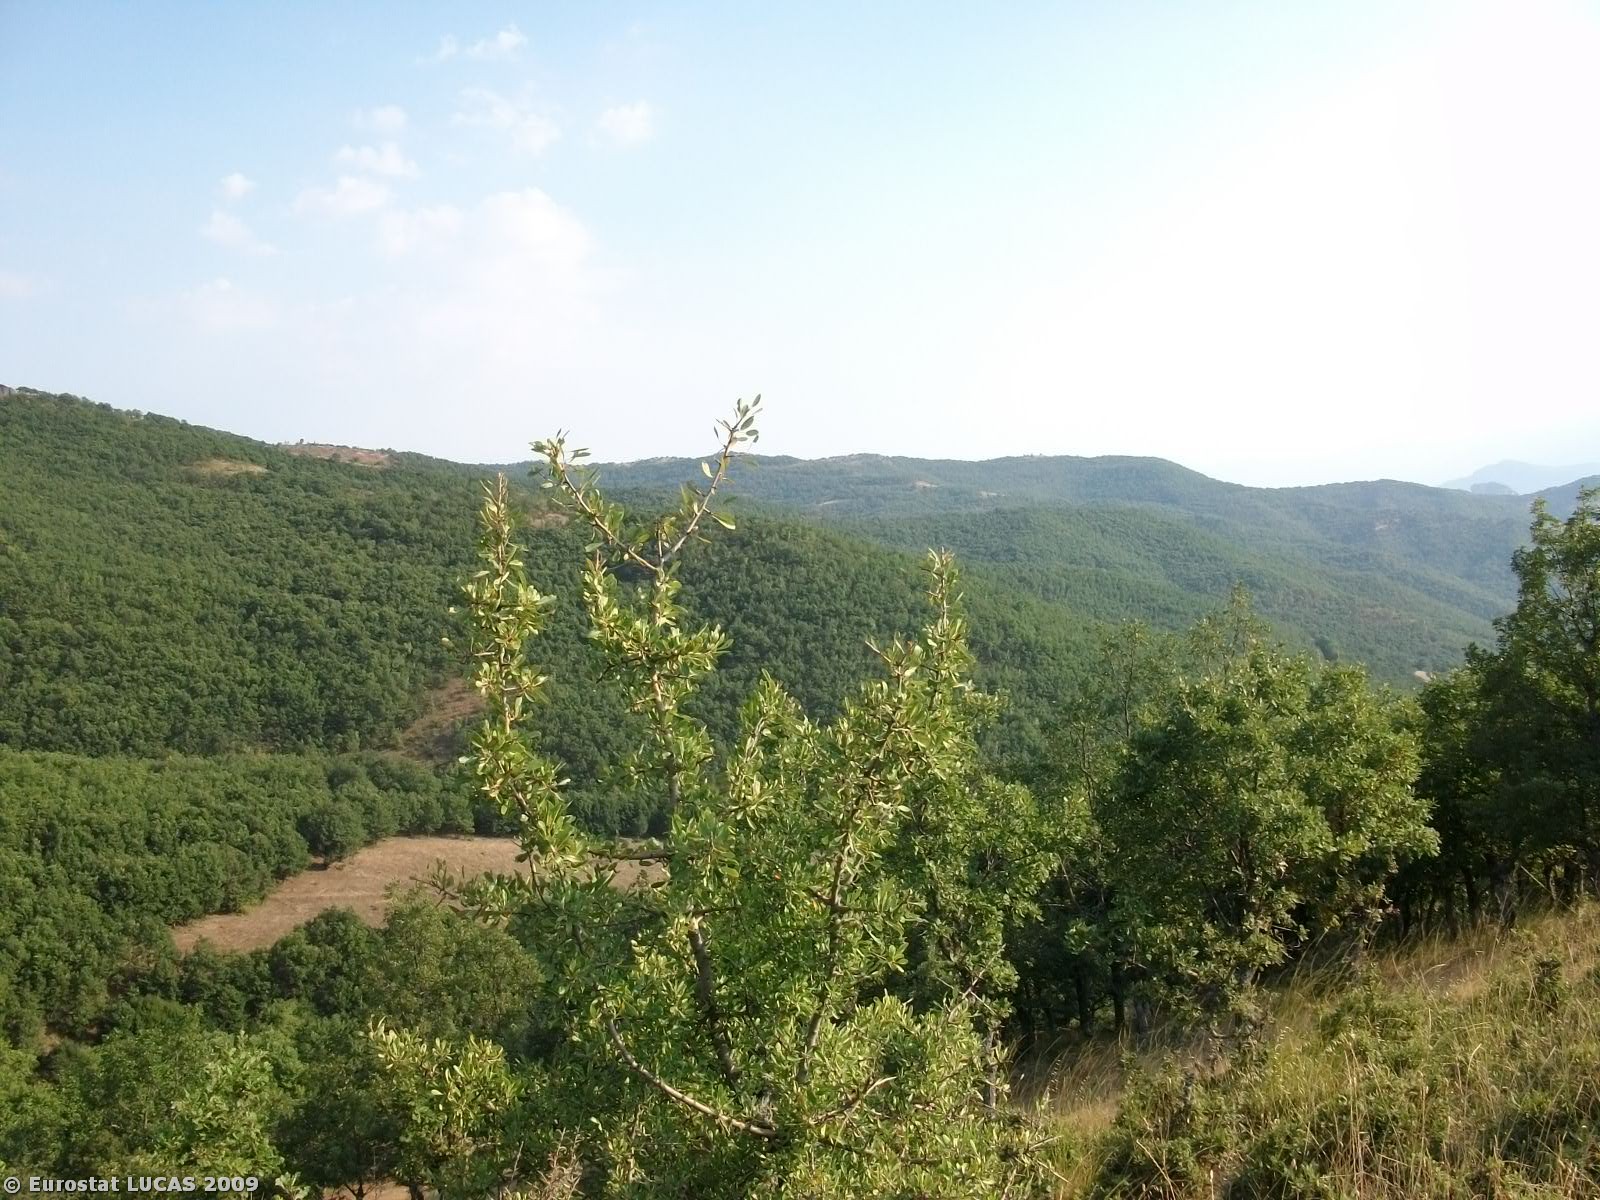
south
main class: Grassland
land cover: Grassland with sparse tree/shrub cover
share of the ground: > 75 %
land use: Unused
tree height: > 5 m
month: August
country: GR
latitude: 39.7541
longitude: 21.6445
